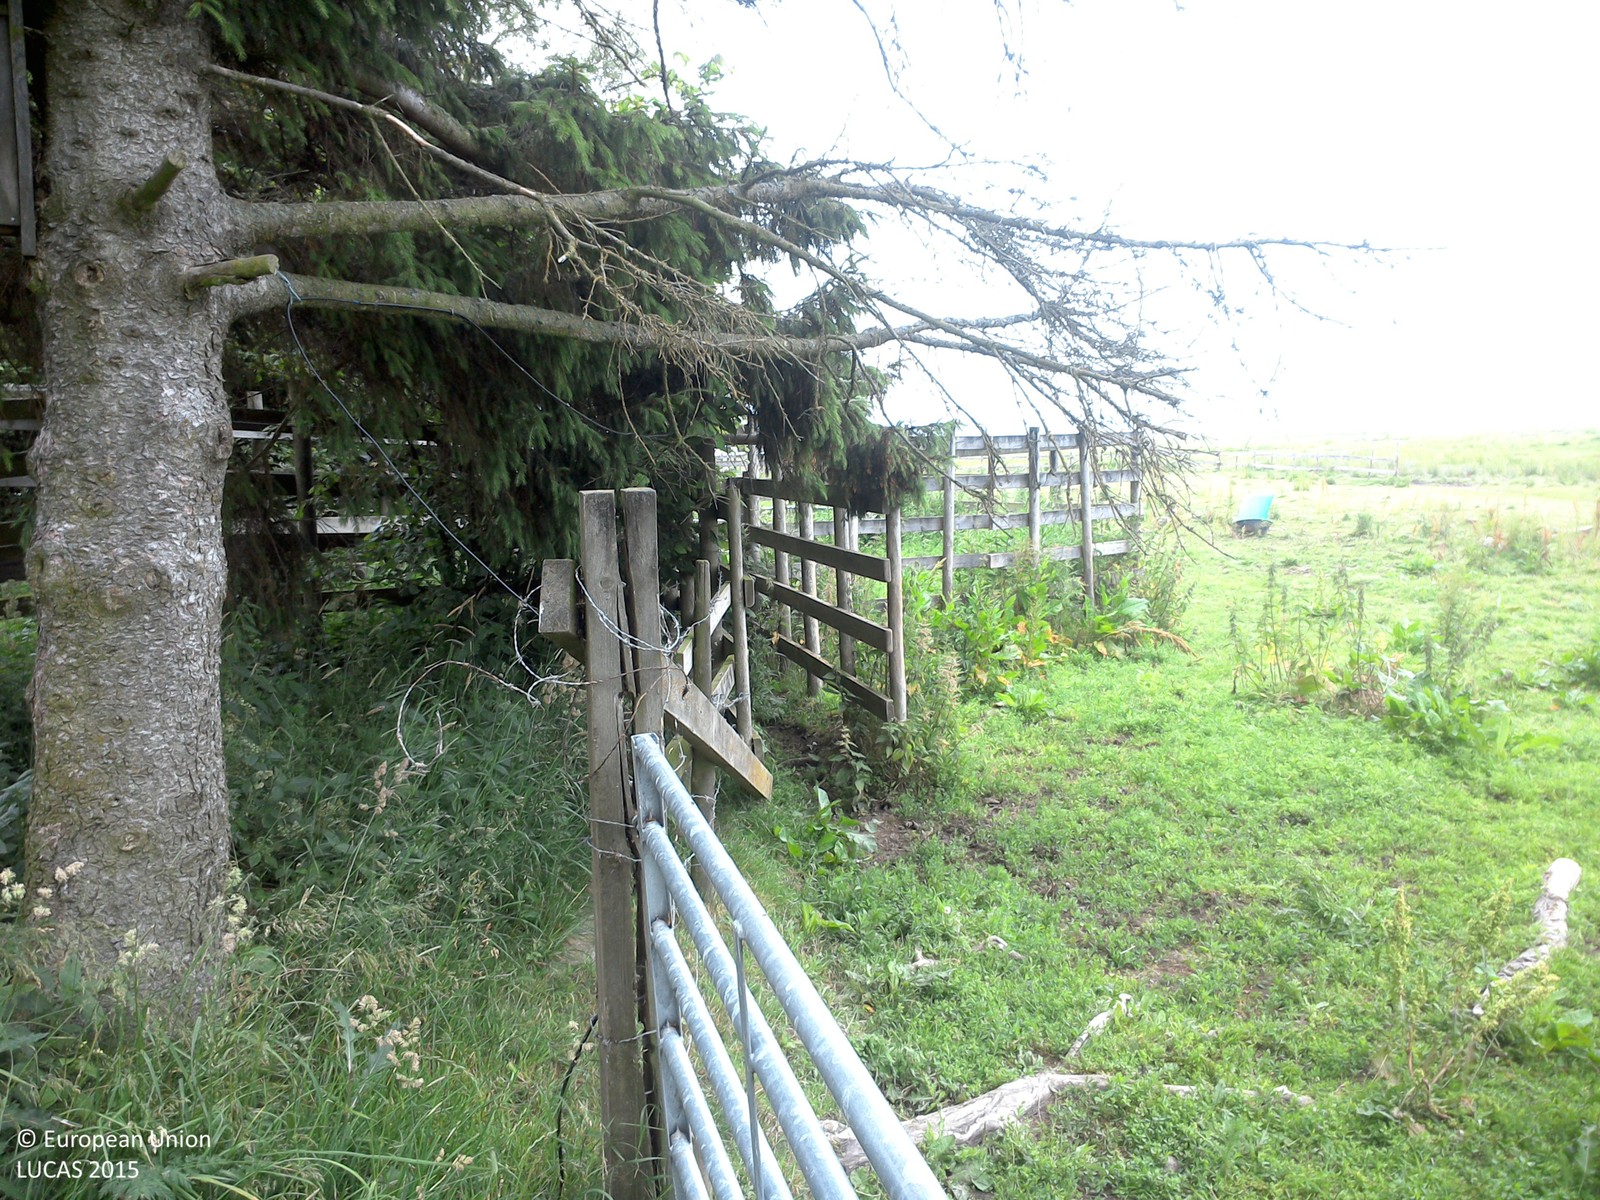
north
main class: Grassland
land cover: Grassland without tree/shrub cover
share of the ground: > 75 %
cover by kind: herbaceous plants 100 %
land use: Agriculture (excluding fallow land and kitchen gardens)
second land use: Amenities, museums, leisure
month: June
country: SE
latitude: 58.4650
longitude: 15.5655
